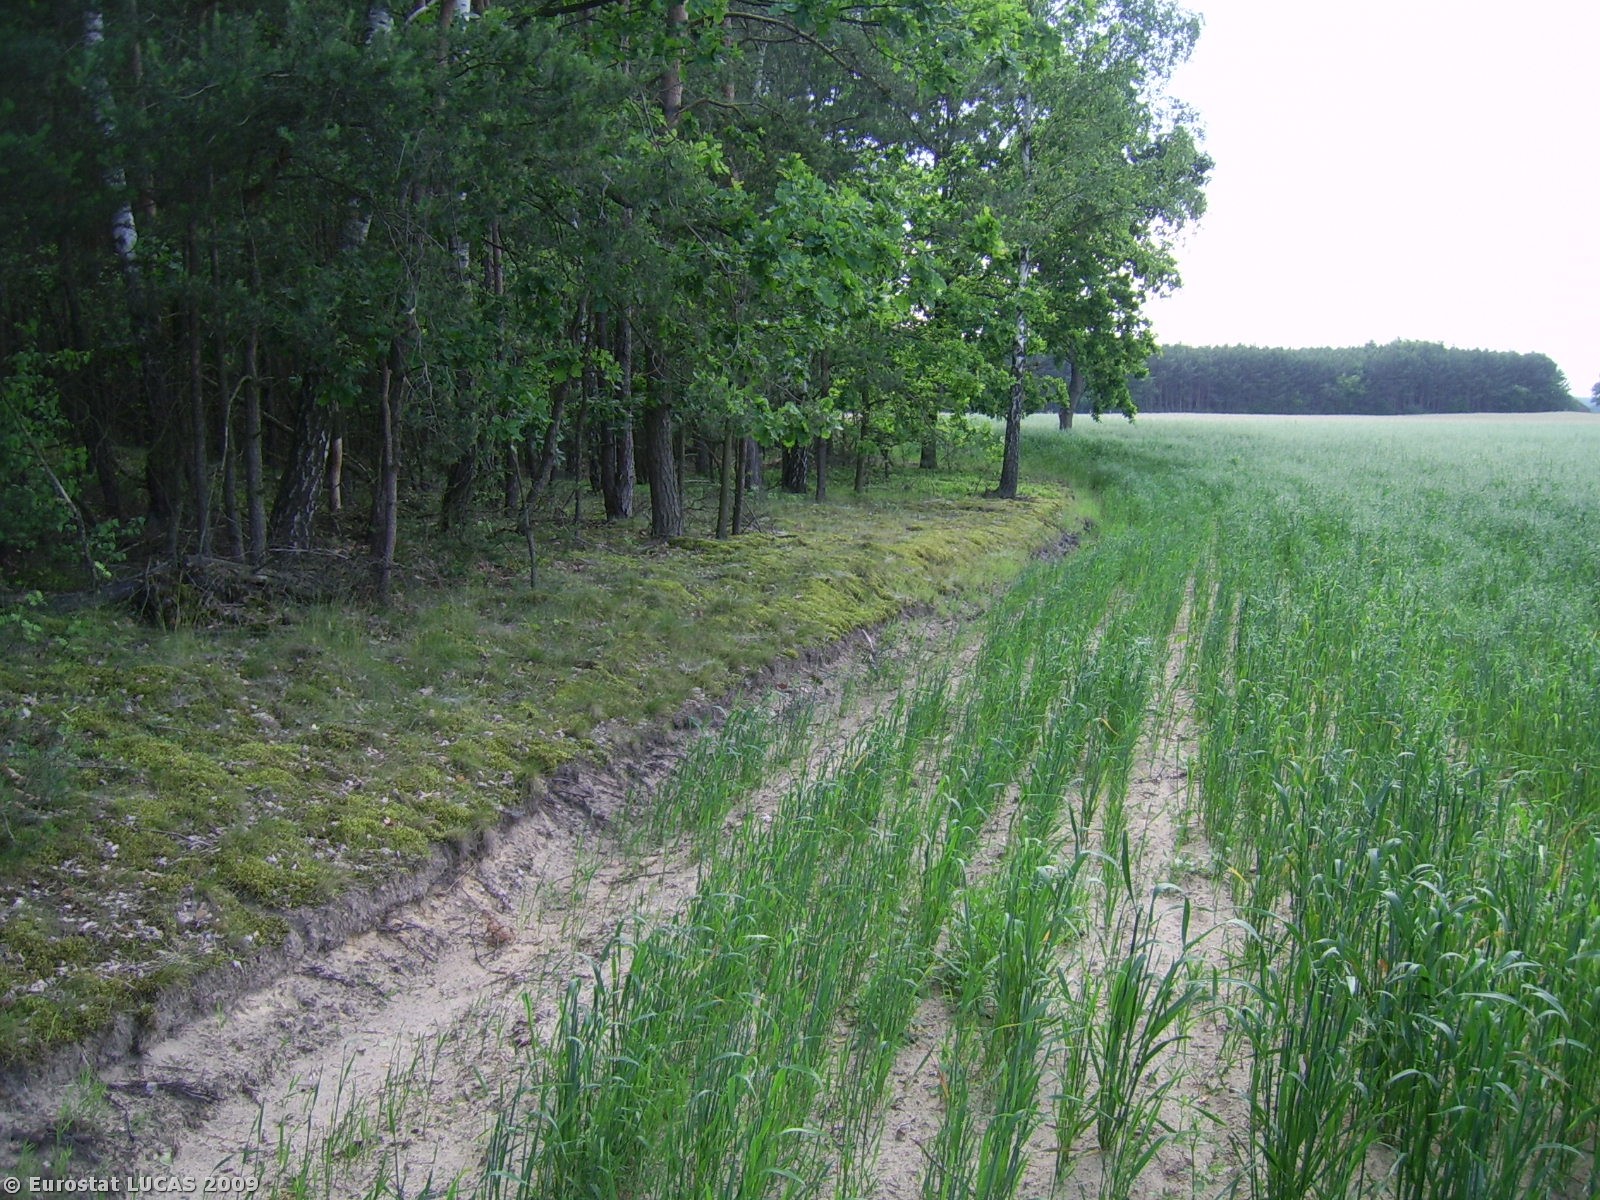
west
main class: Cropland
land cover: Oats
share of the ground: > 75 %
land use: Agriculture (excluding fallow land and kitchen gardens)
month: June
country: PL
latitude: 52.1029
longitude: 17.7959
